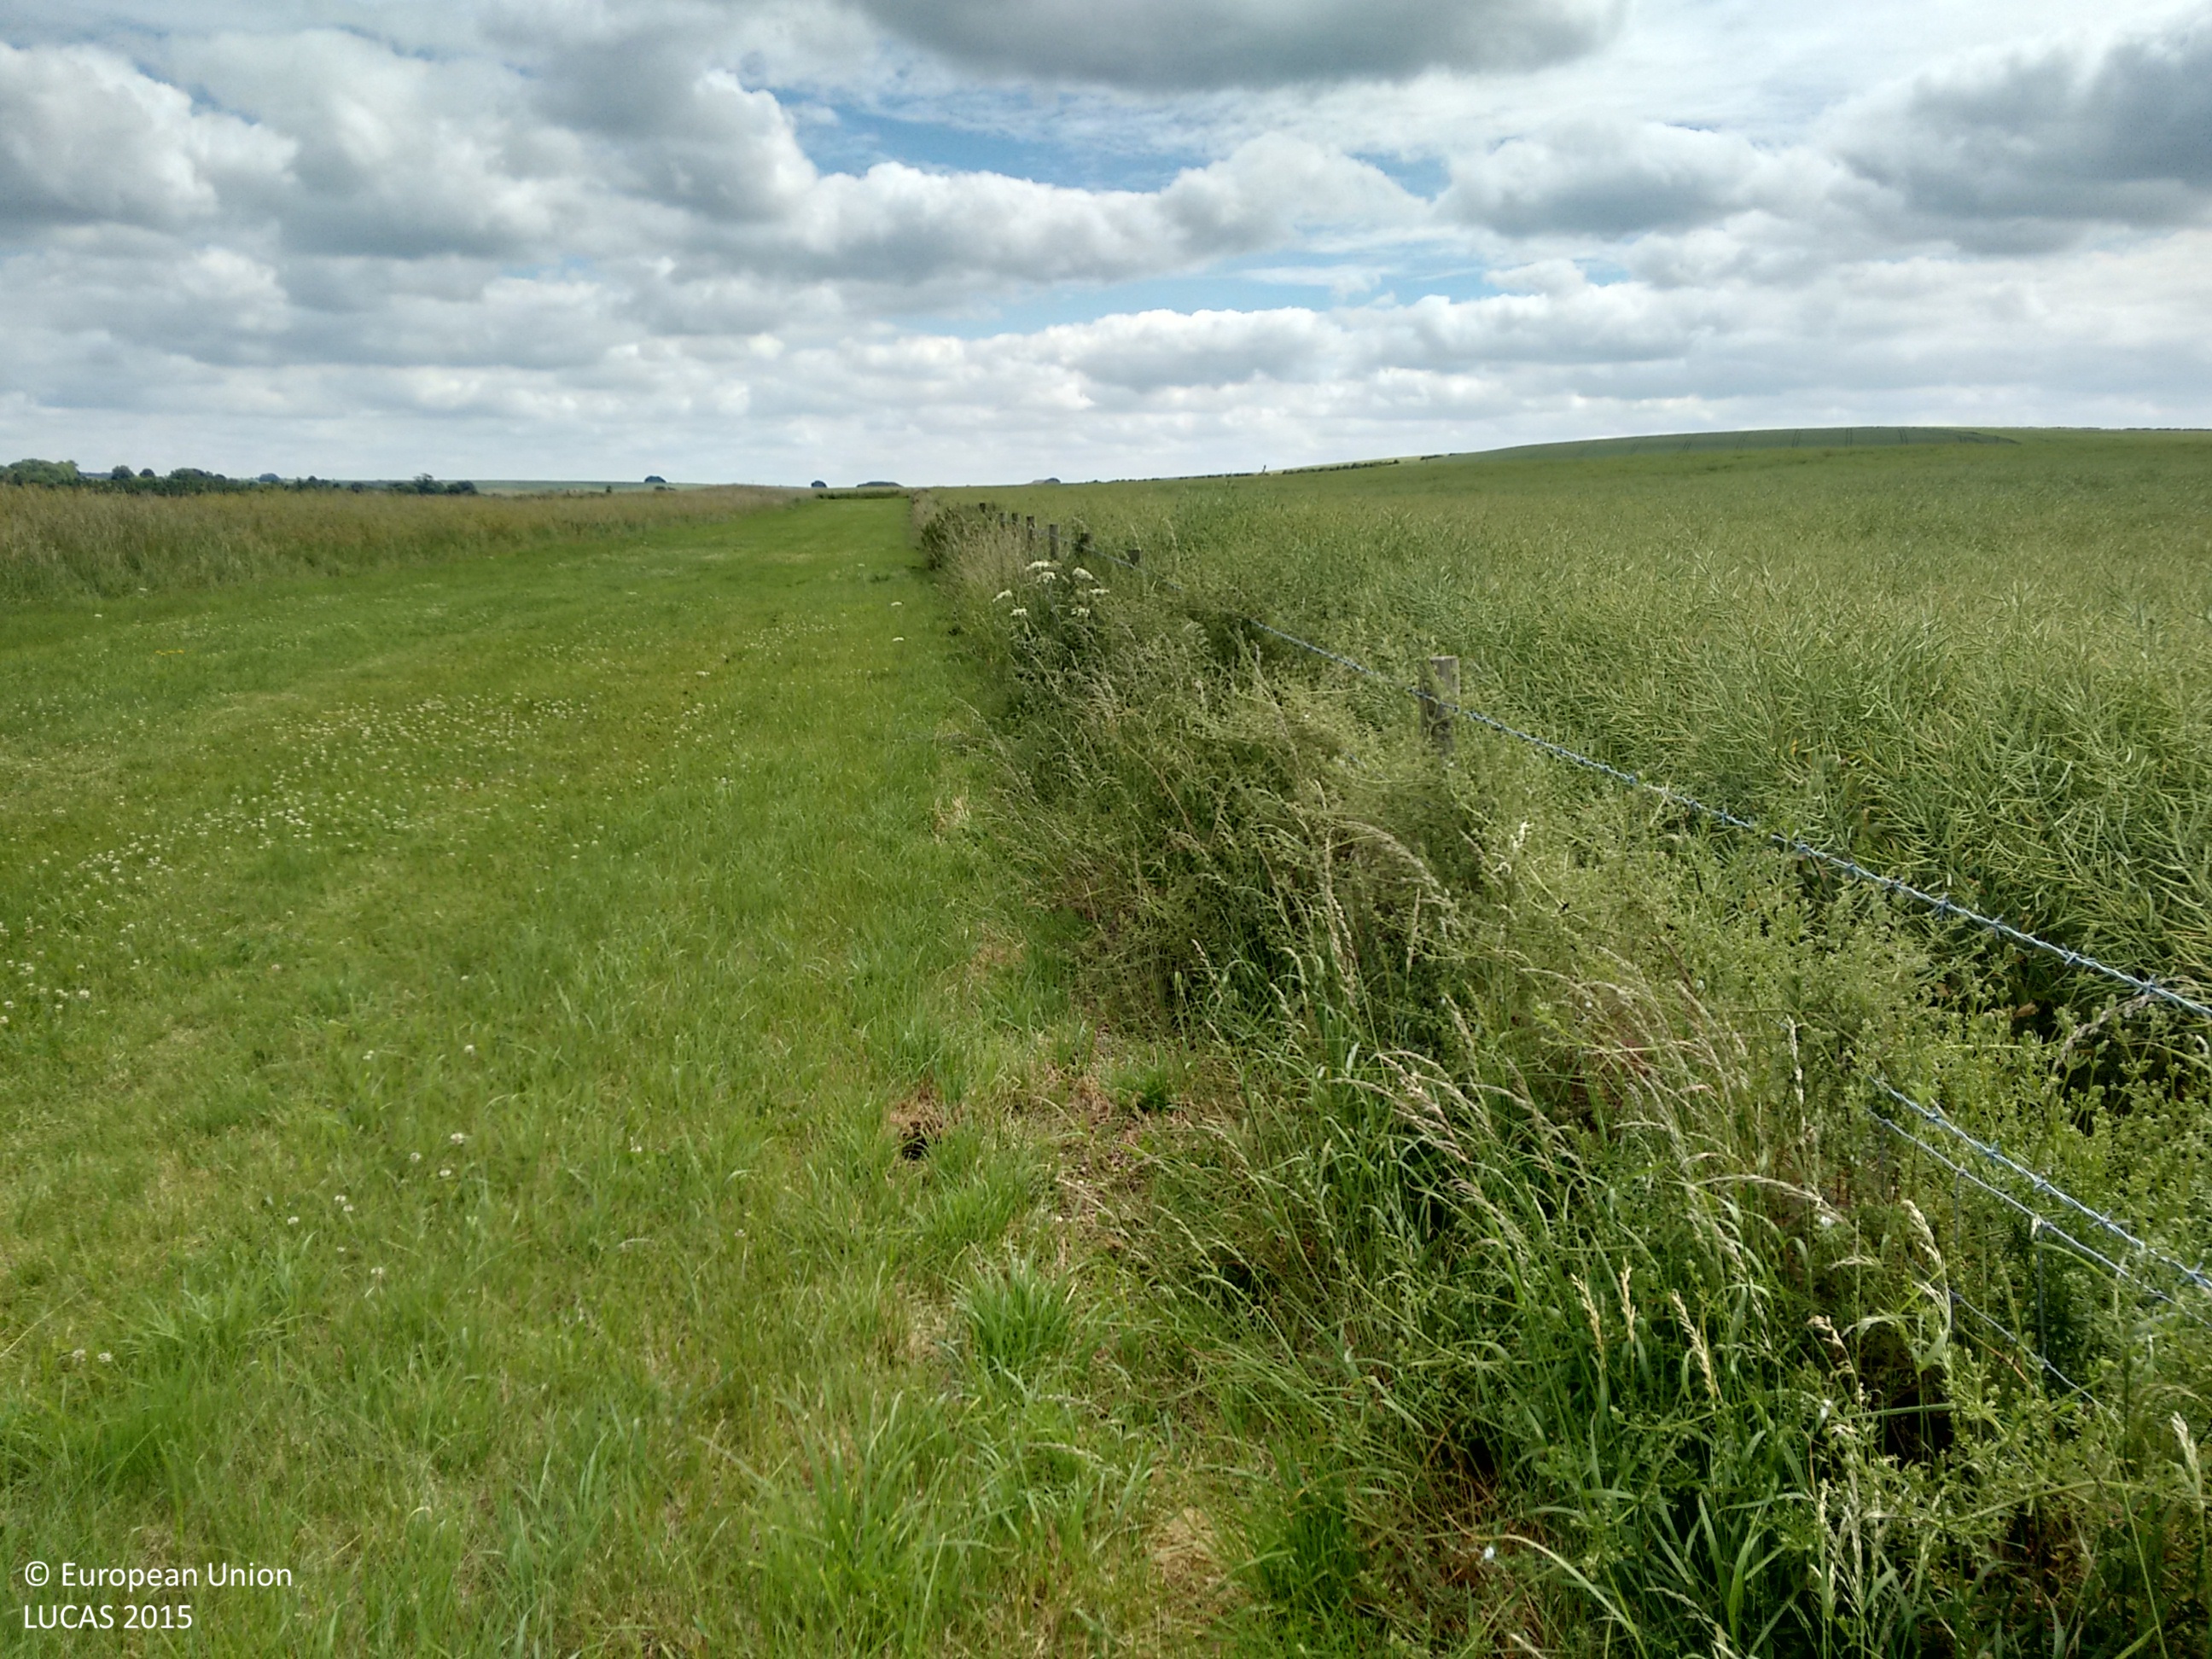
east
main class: Cropland
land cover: Rape and turnip rape
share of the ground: > 75 %
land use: Agriculture (excluding fallow land and kitchen gardens)
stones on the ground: 25 - 50 %
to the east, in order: Rape and turnip rape; Shruby margins; Barley
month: June
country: GB
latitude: 51.4138
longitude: -1.8902
